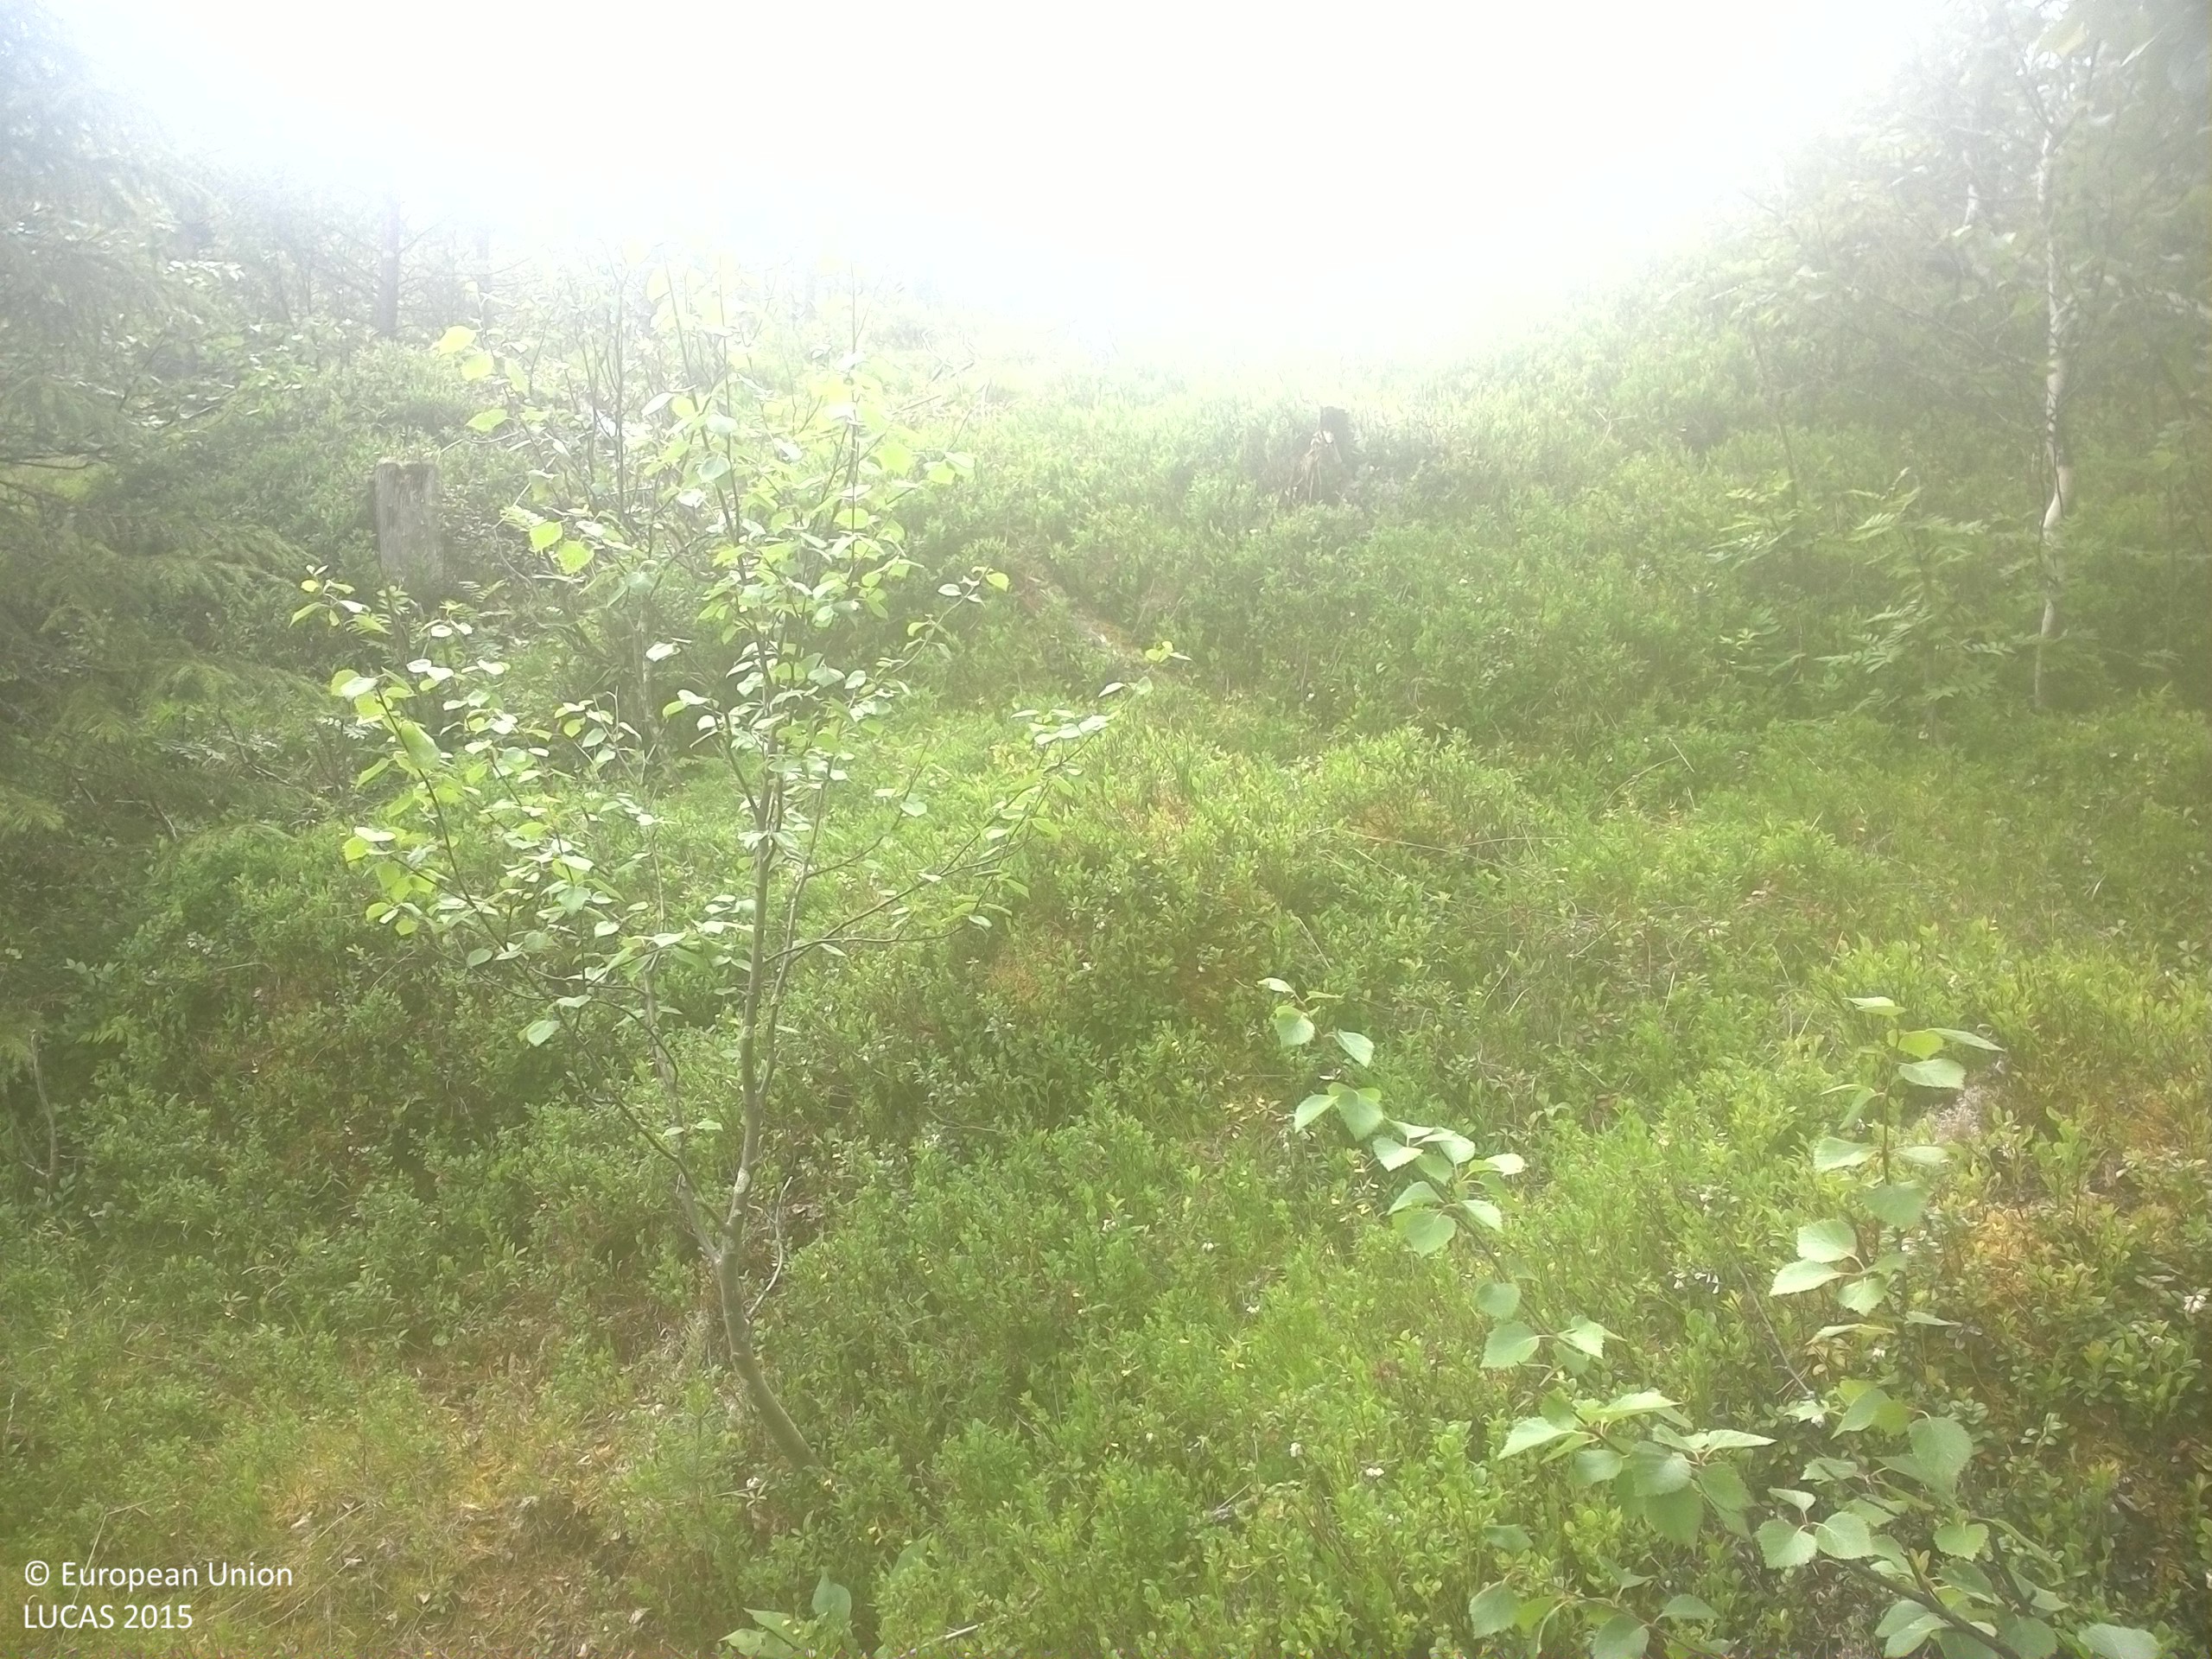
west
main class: Woodland
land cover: Spruce dominated mixed woodland
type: boreal forest
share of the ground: 50 - 75 %
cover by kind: coniferous forest trees 45 %, lichens and mosses 20 %, broadleaved forest trees 15 %, shrubs 15 %, herbaceous plants 5 %
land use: Forestry
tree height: > 5 m
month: July
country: SE
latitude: 63.6108
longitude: 18.4245
